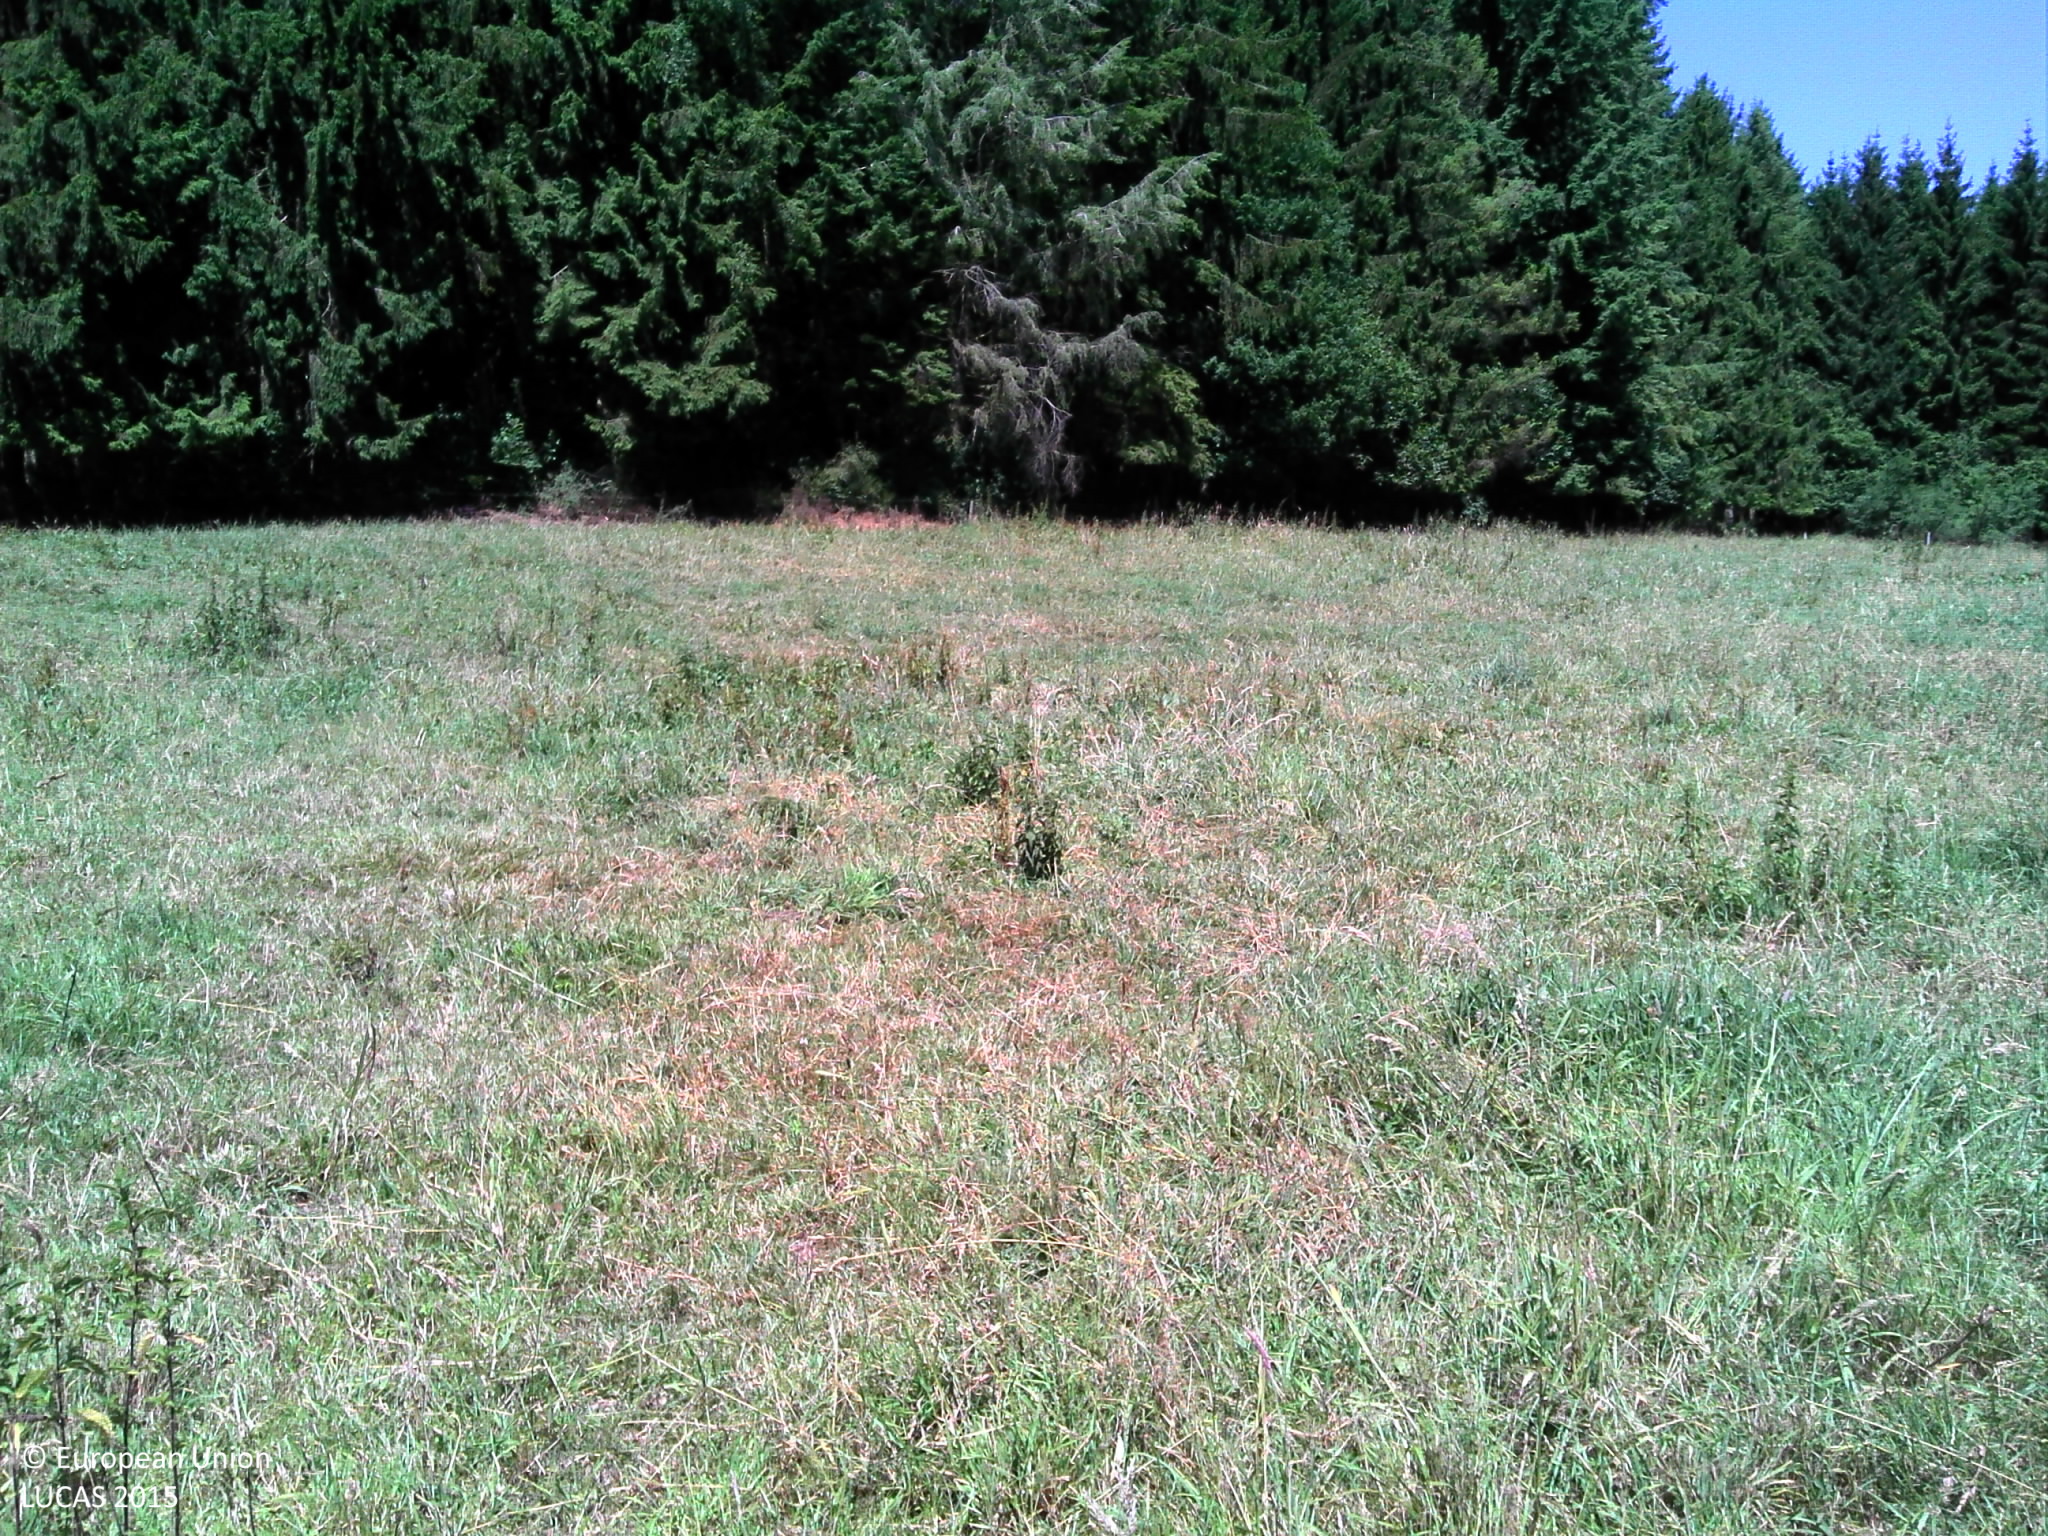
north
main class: Grassland
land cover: Grassland without tree/shrub cover
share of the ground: > 75 %
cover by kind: herbaceous plants 100 %
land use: Agriculture (excluding fallow land and kitchen gardens)
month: July
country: BE
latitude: 50.0823
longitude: 5.6243
